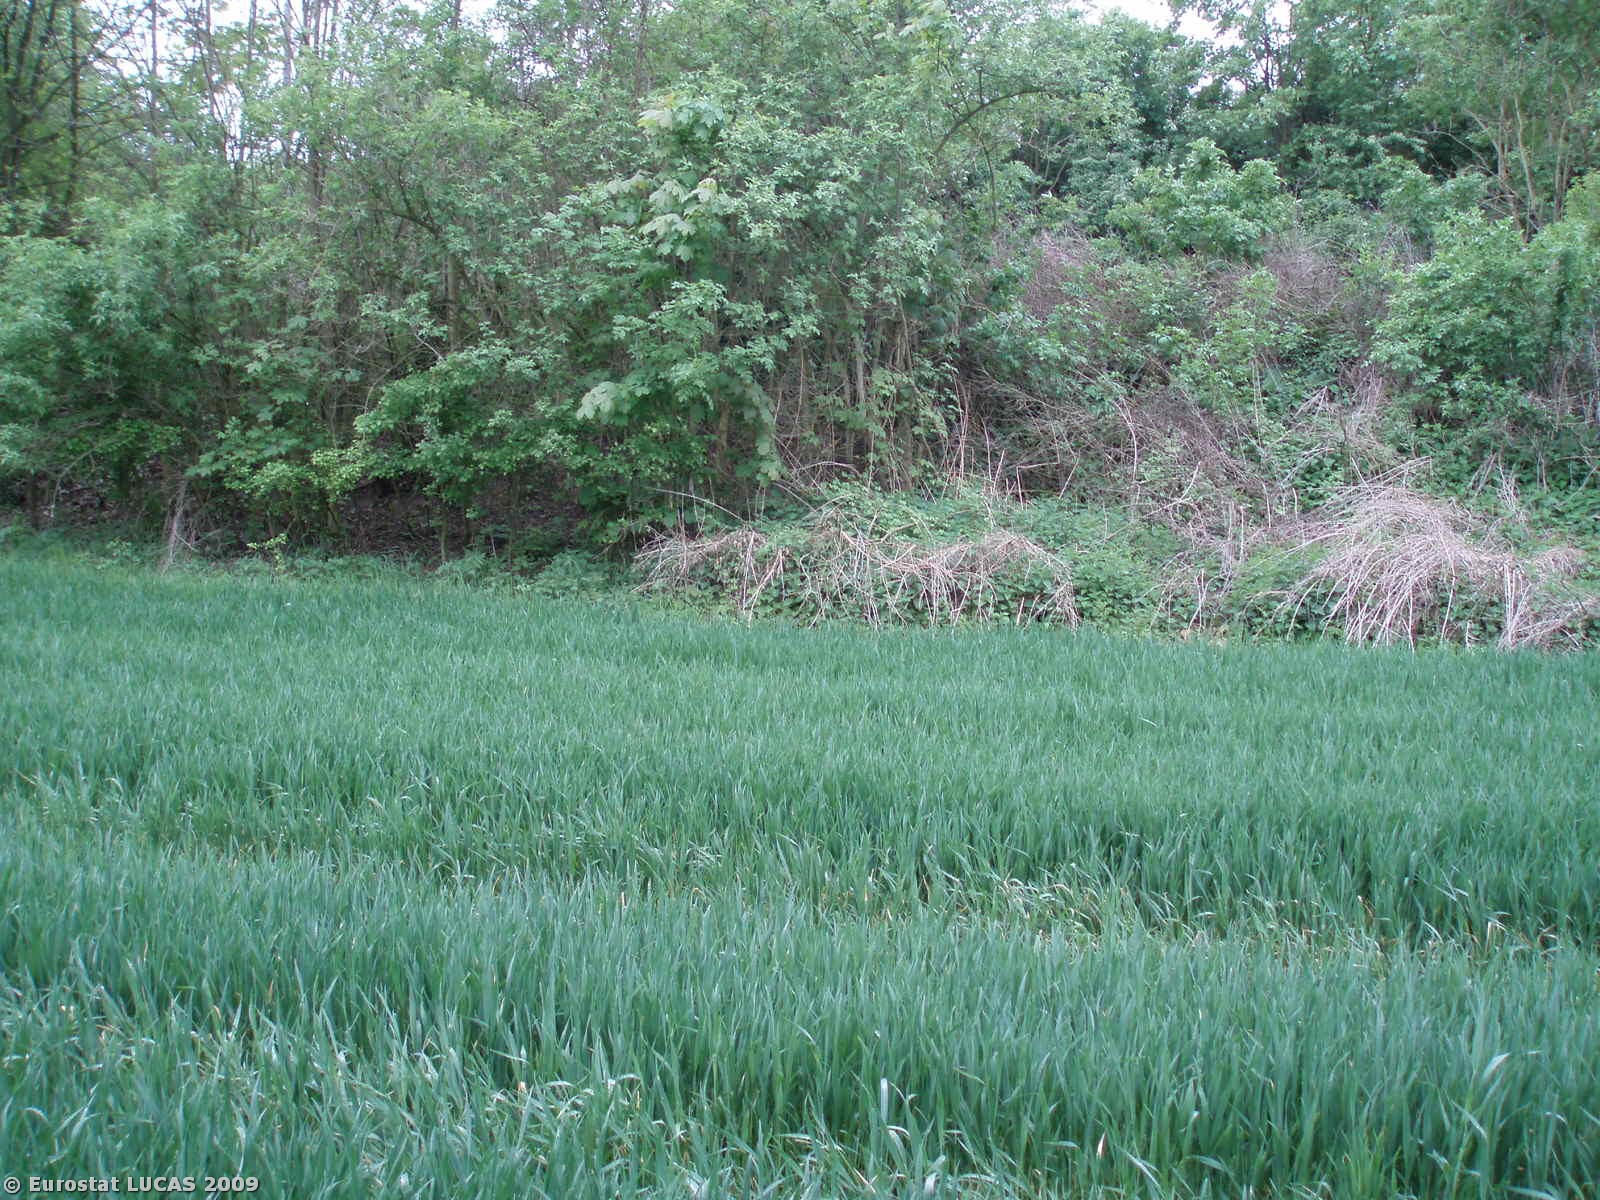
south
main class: Woodland
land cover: Broadleaved woodland
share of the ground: > 75 %
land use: Unused
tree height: > 5 m
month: May
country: CZ
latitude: 50.2163
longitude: 14.1634
